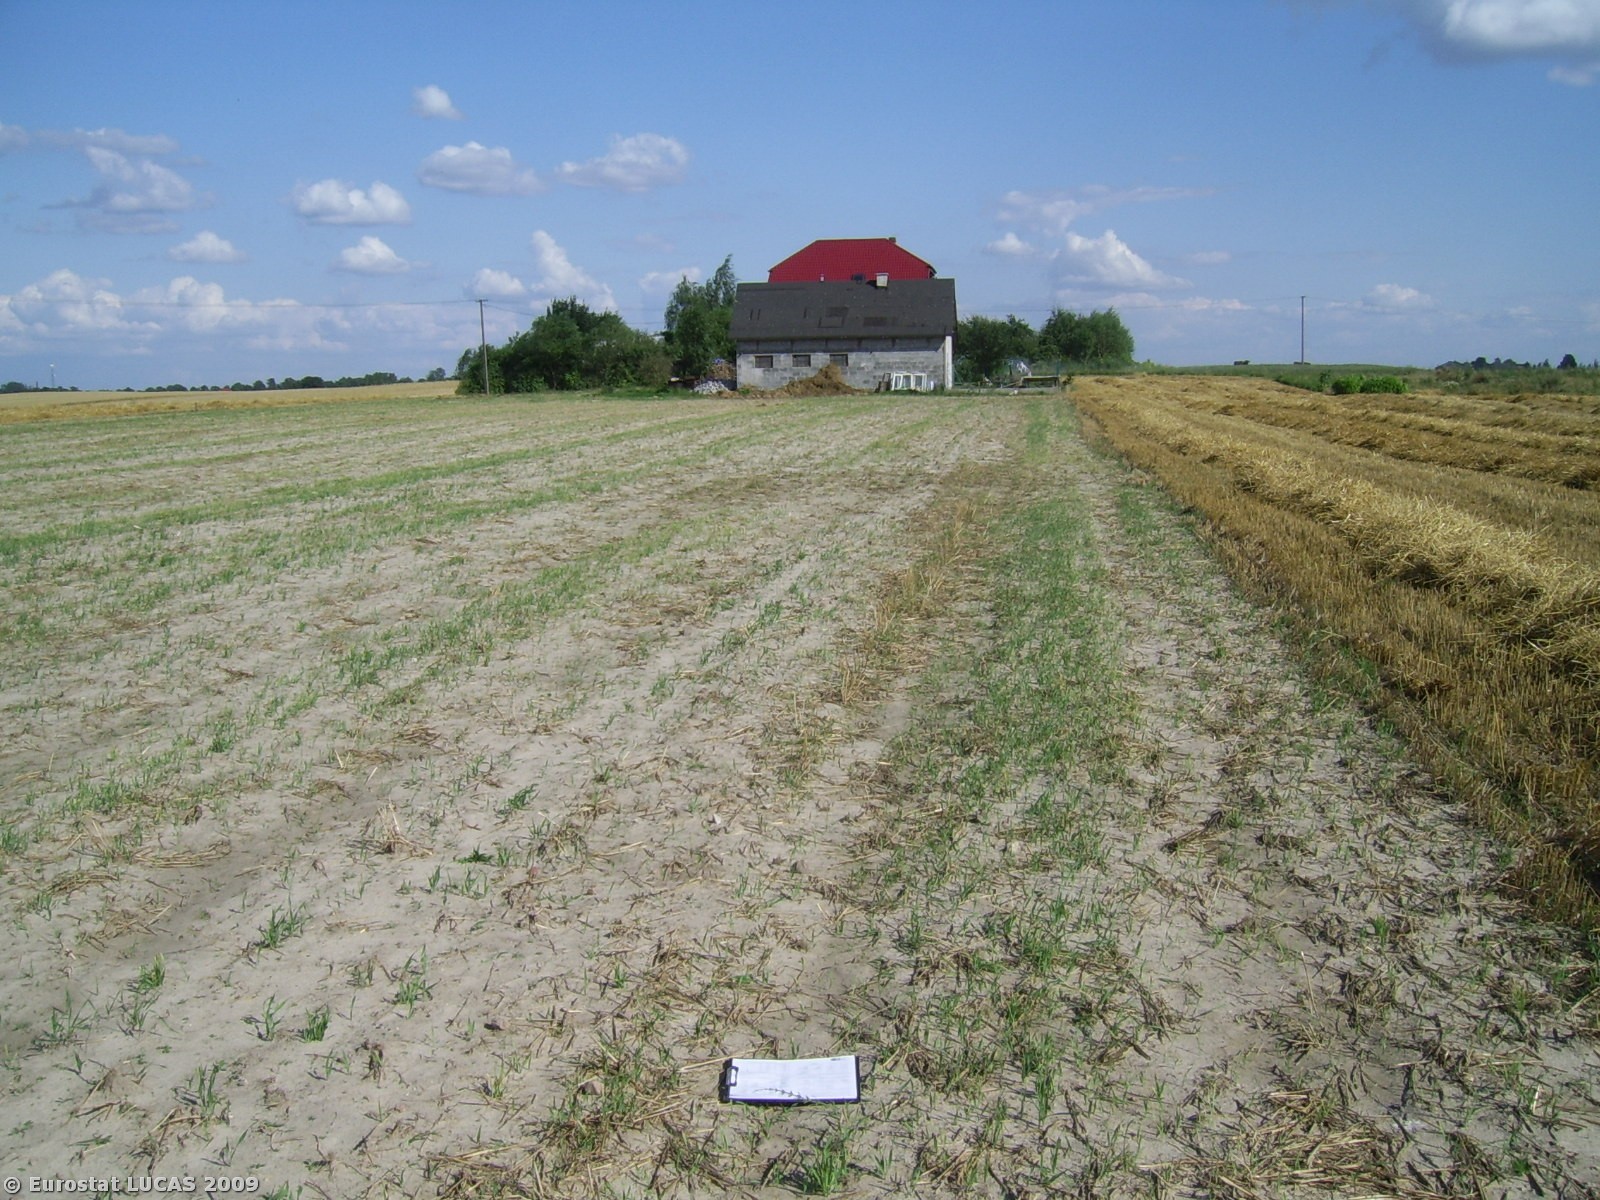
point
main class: Cropland
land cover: Barley
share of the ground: < 10 %
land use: Agriculture (excluding fallow land and kitchen gardens)
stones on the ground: < 10 %
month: August
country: PL
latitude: 53.1023
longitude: 18.7582
